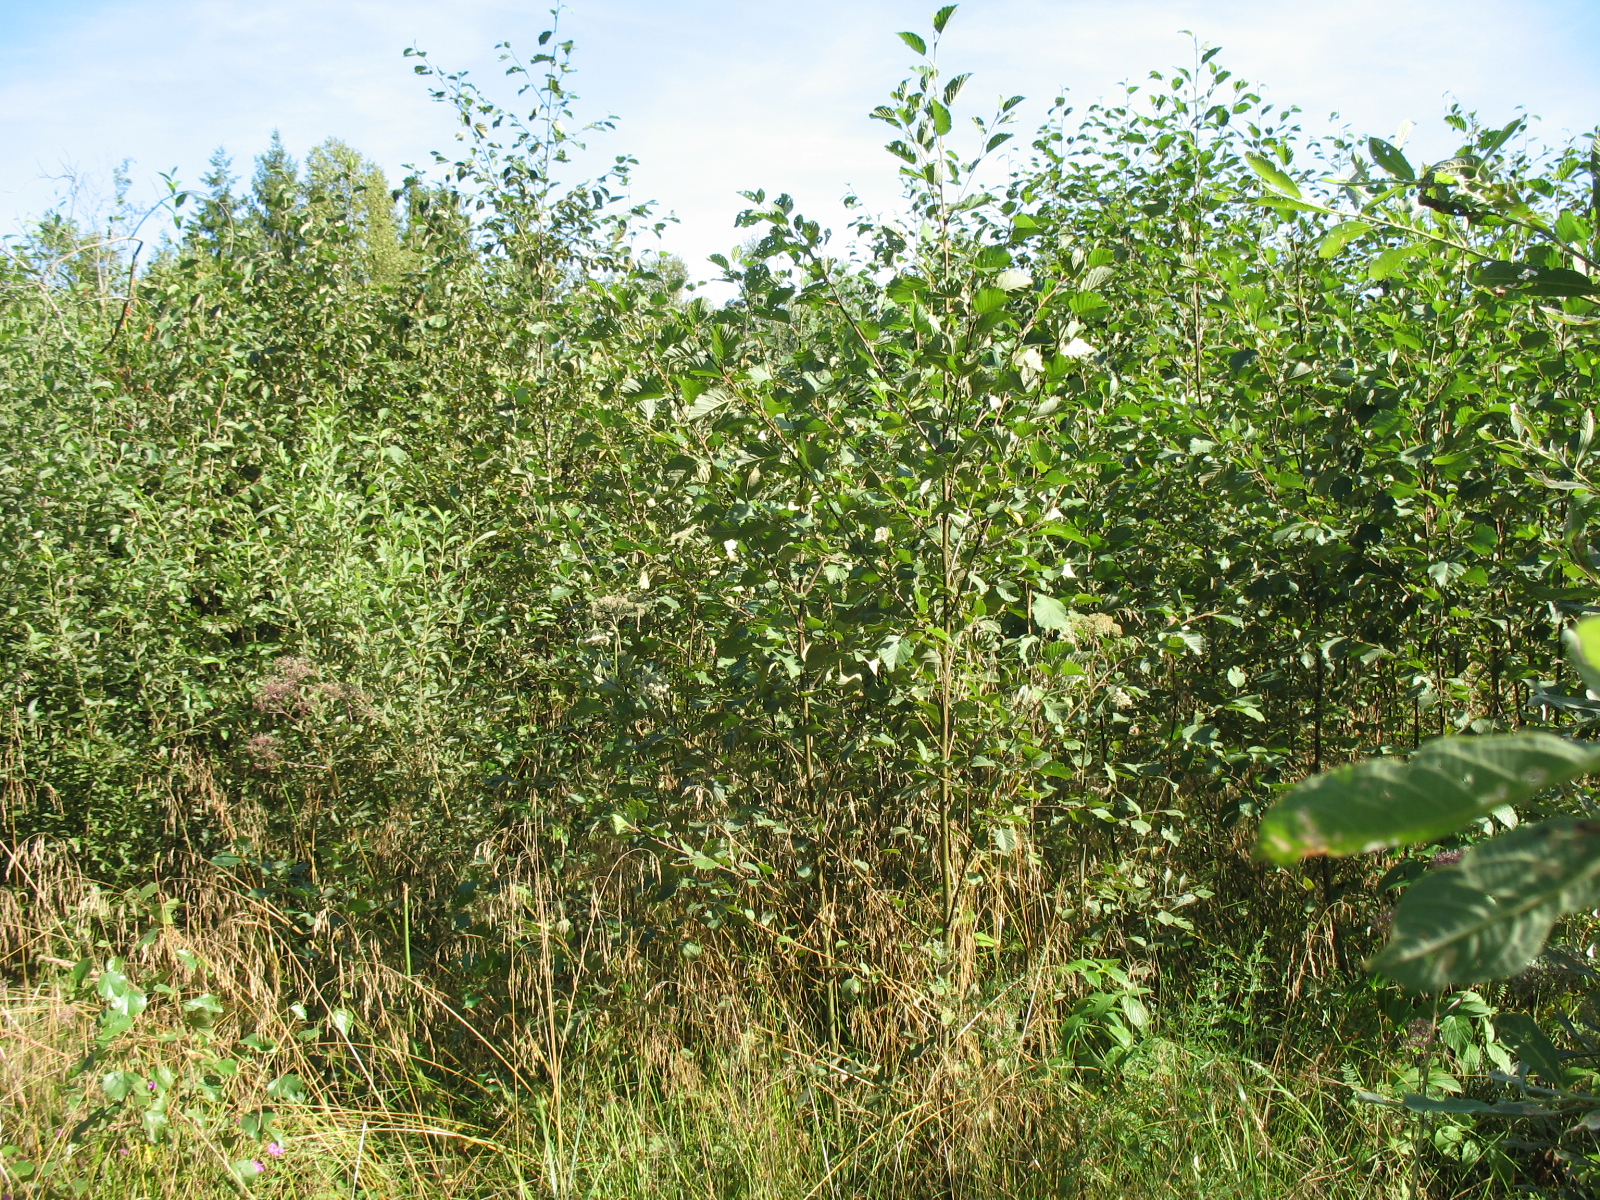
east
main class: Woodland
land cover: Broadleaved woodland
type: non-riverine alder, birch or aspen forest
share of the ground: 50 - 75 %
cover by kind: broadleaved forest trees 55 %, herbaceous plants 30 %, shrubs 15 %
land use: Forestry
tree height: < 5 m
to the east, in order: Broadleaved woodland; Spruce dominated coniferous woodland; Spruce dominated mixed woodland; Broadleaved woodland
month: August
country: LV
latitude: 56.4190
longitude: 26.0377
